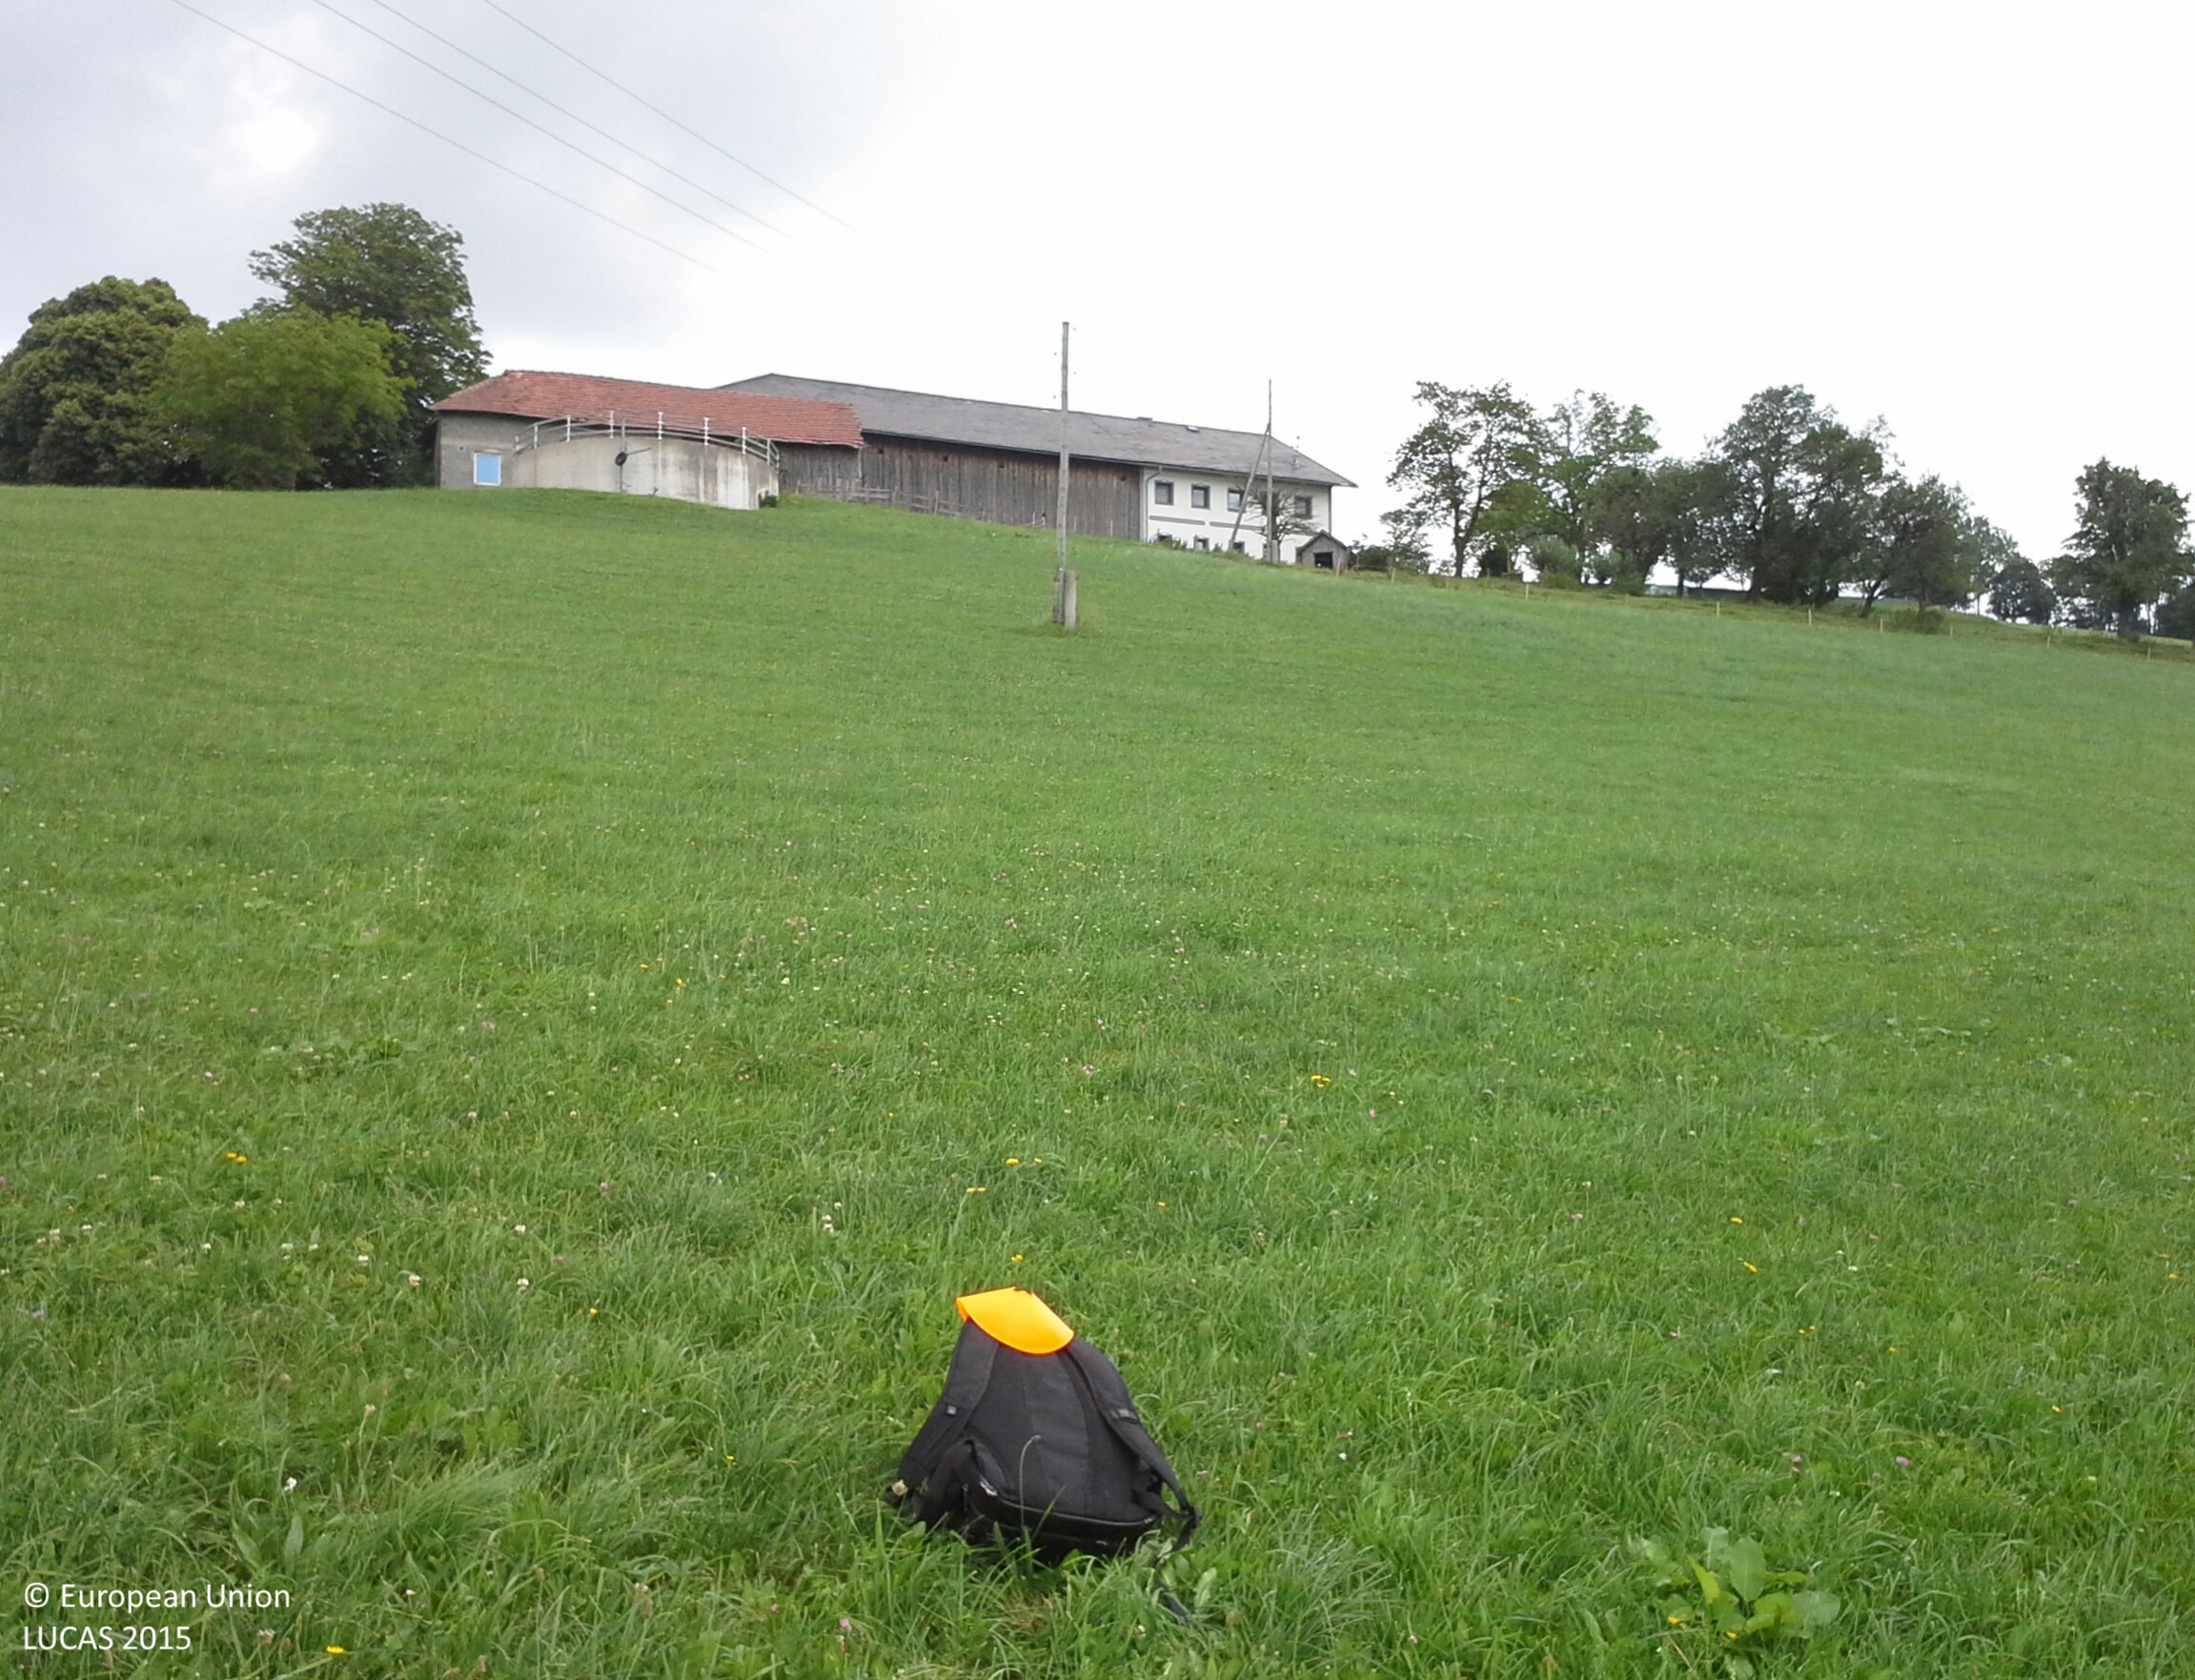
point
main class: Grassland
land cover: Grassland without tree/shrub cover
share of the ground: > 75 %
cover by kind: herbaceous plants 100 %
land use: Agriculture (excluding fallow land and kitchen gardens)
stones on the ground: > 50 %
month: July
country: AT
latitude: 47.9656
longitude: 14.5941
